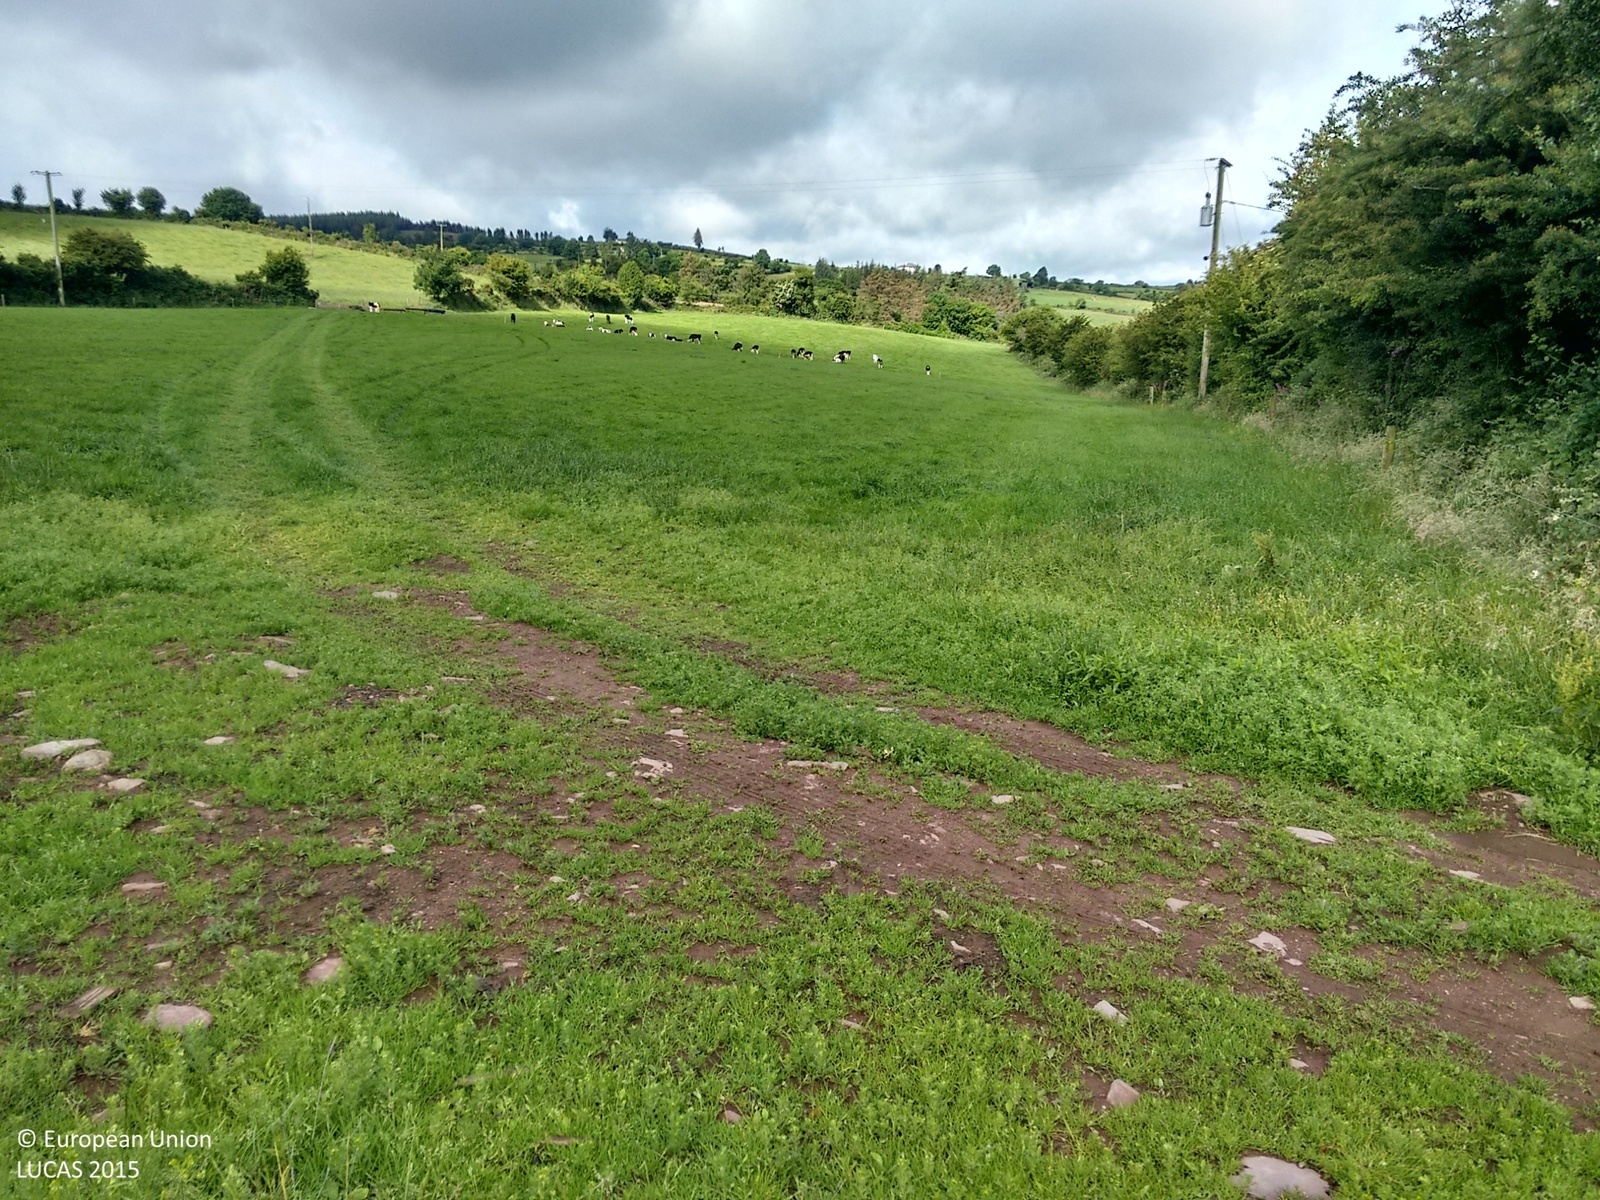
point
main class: Grassland
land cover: Grassland without tree/shrub cover
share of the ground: > 75 %
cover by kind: herbaceous plants 100 %
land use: Agriculture (excluding fallow land and kitchen gardens)
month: July
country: IE
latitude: 52.2475
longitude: -8.1836
